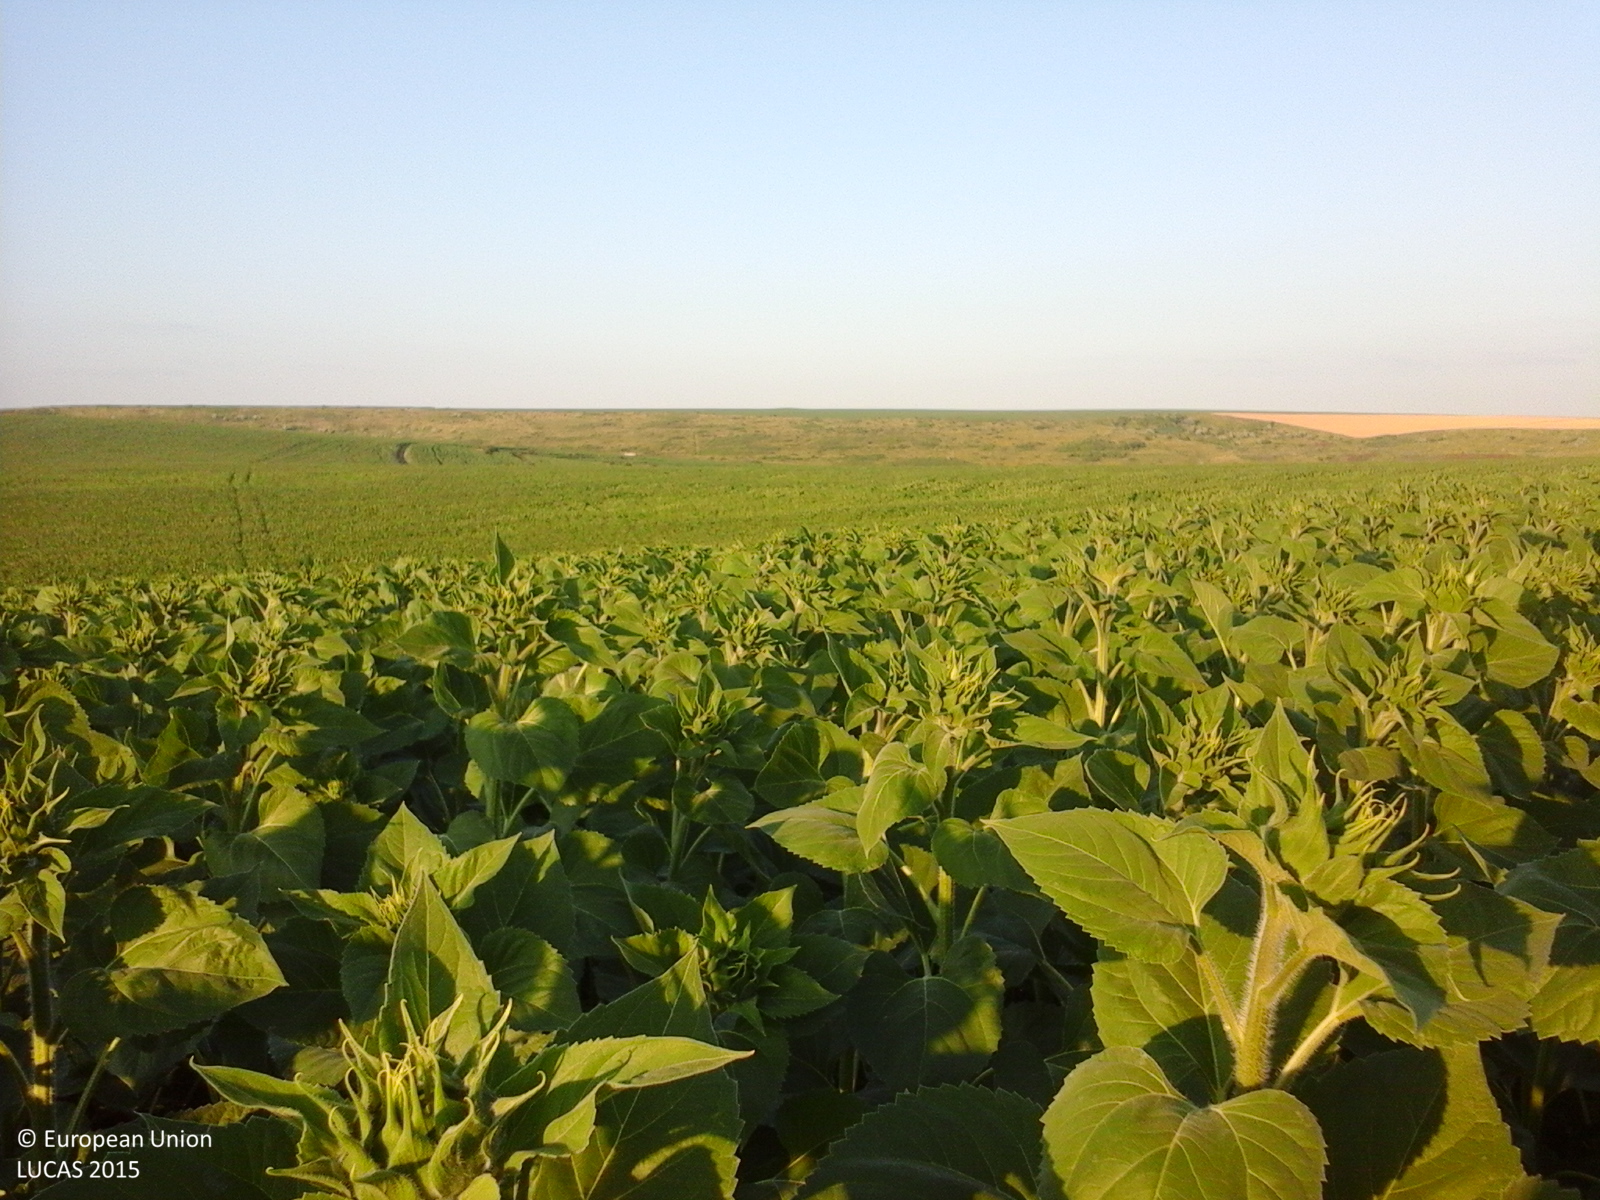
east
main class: Cropland
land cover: Sunflower
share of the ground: > 75 %
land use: Agriculture (excluding fallow land and kitchen gardens)
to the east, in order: Sunflower
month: June
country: RO
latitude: 47.3952
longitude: 27.4044
